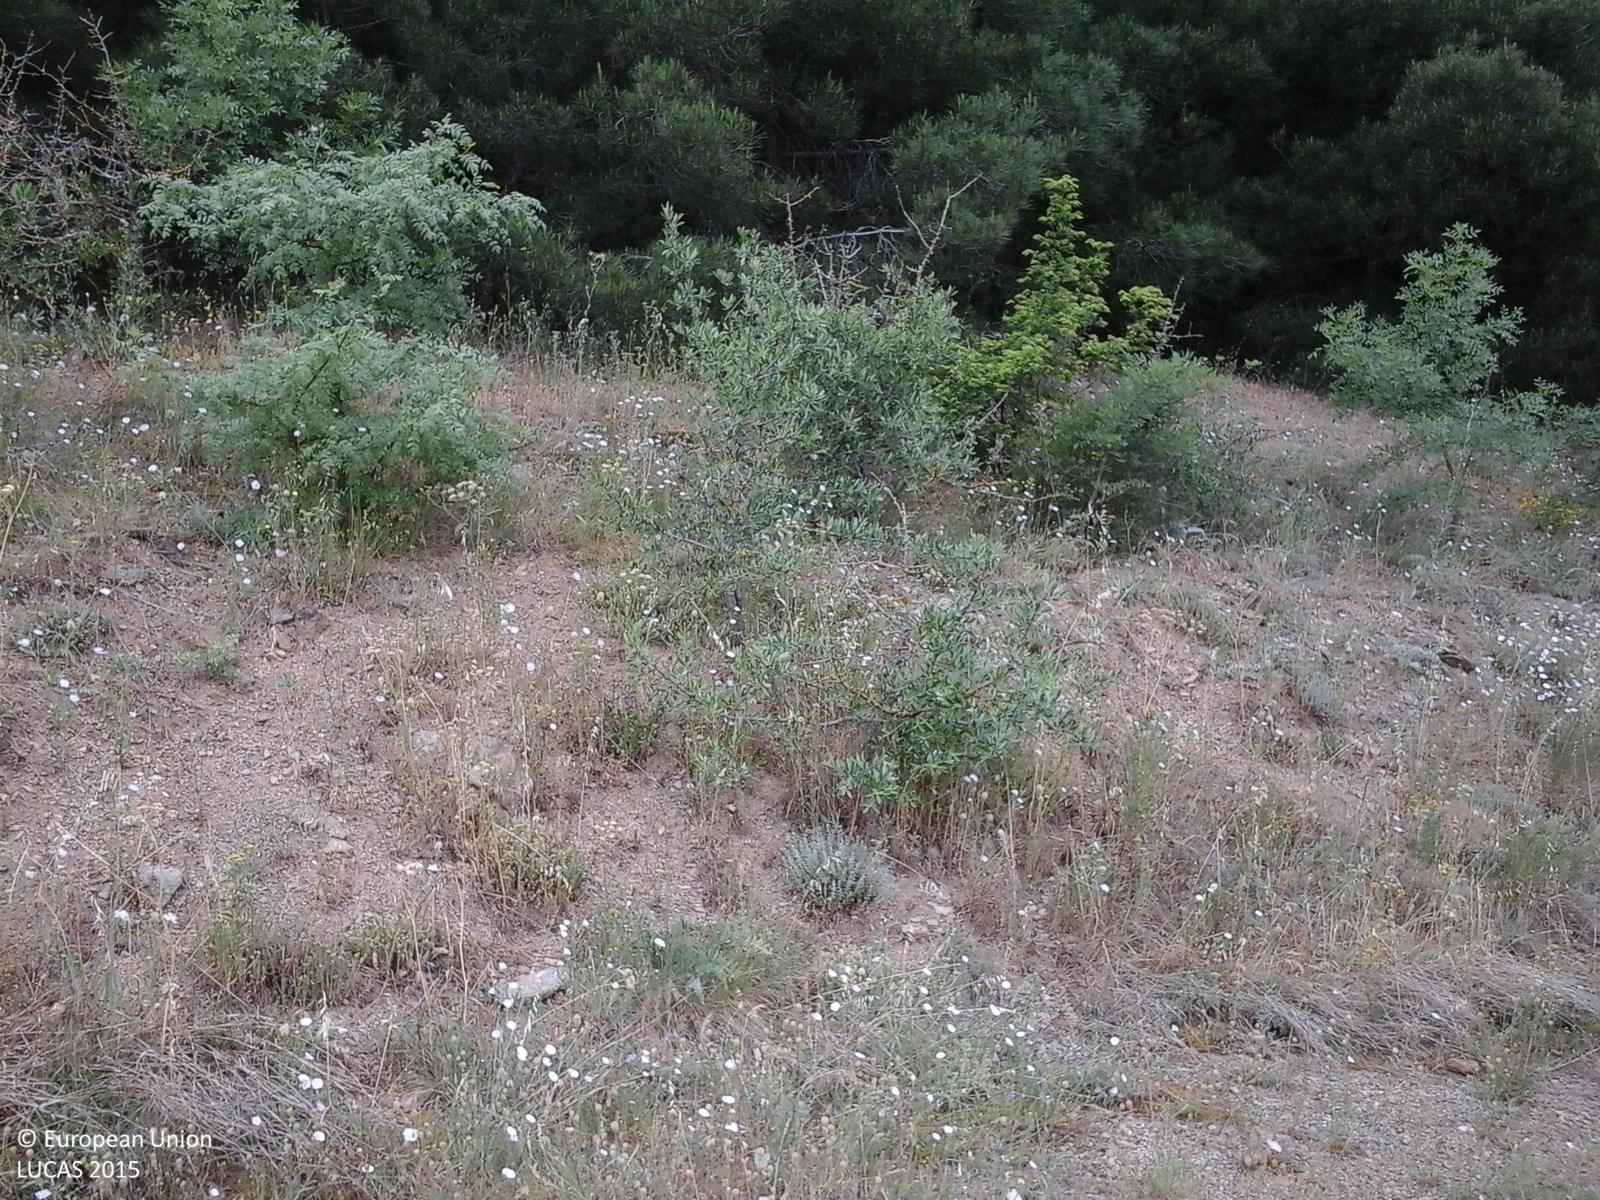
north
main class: Shrubland
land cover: Shrubland without tree cover
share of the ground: > 75 %
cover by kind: shrubs 95 %, herbaceous plants 5 %
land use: Semi-natural and natural areas not in use
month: May
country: GR
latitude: 40.7403
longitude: 22.9519
